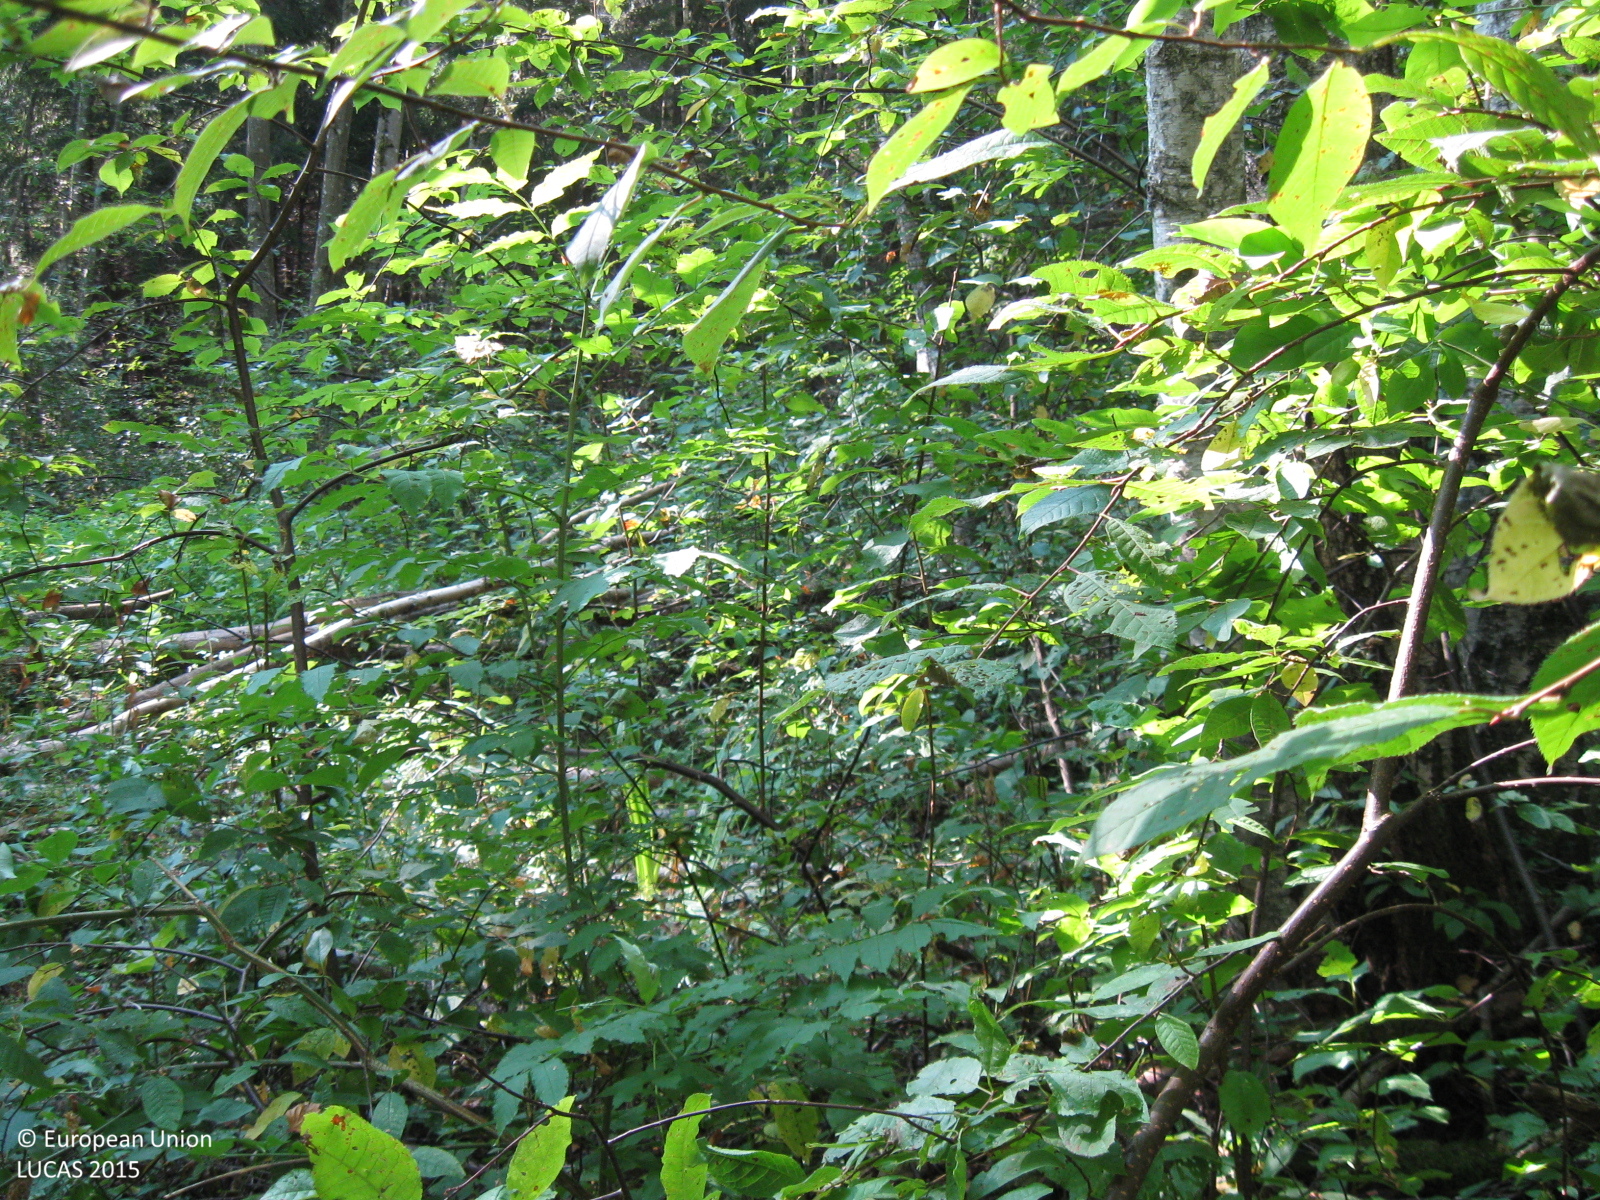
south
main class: Woodland
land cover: Broadleaved woodland
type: non-riverine alder, birch or aspen forest
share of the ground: > 75 %
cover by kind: broadleaved forest trees 95 %, herbaceous plants 5 %
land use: Forestry
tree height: > 5 m
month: August
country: LT
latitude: 55.4929
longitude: 22.9366
